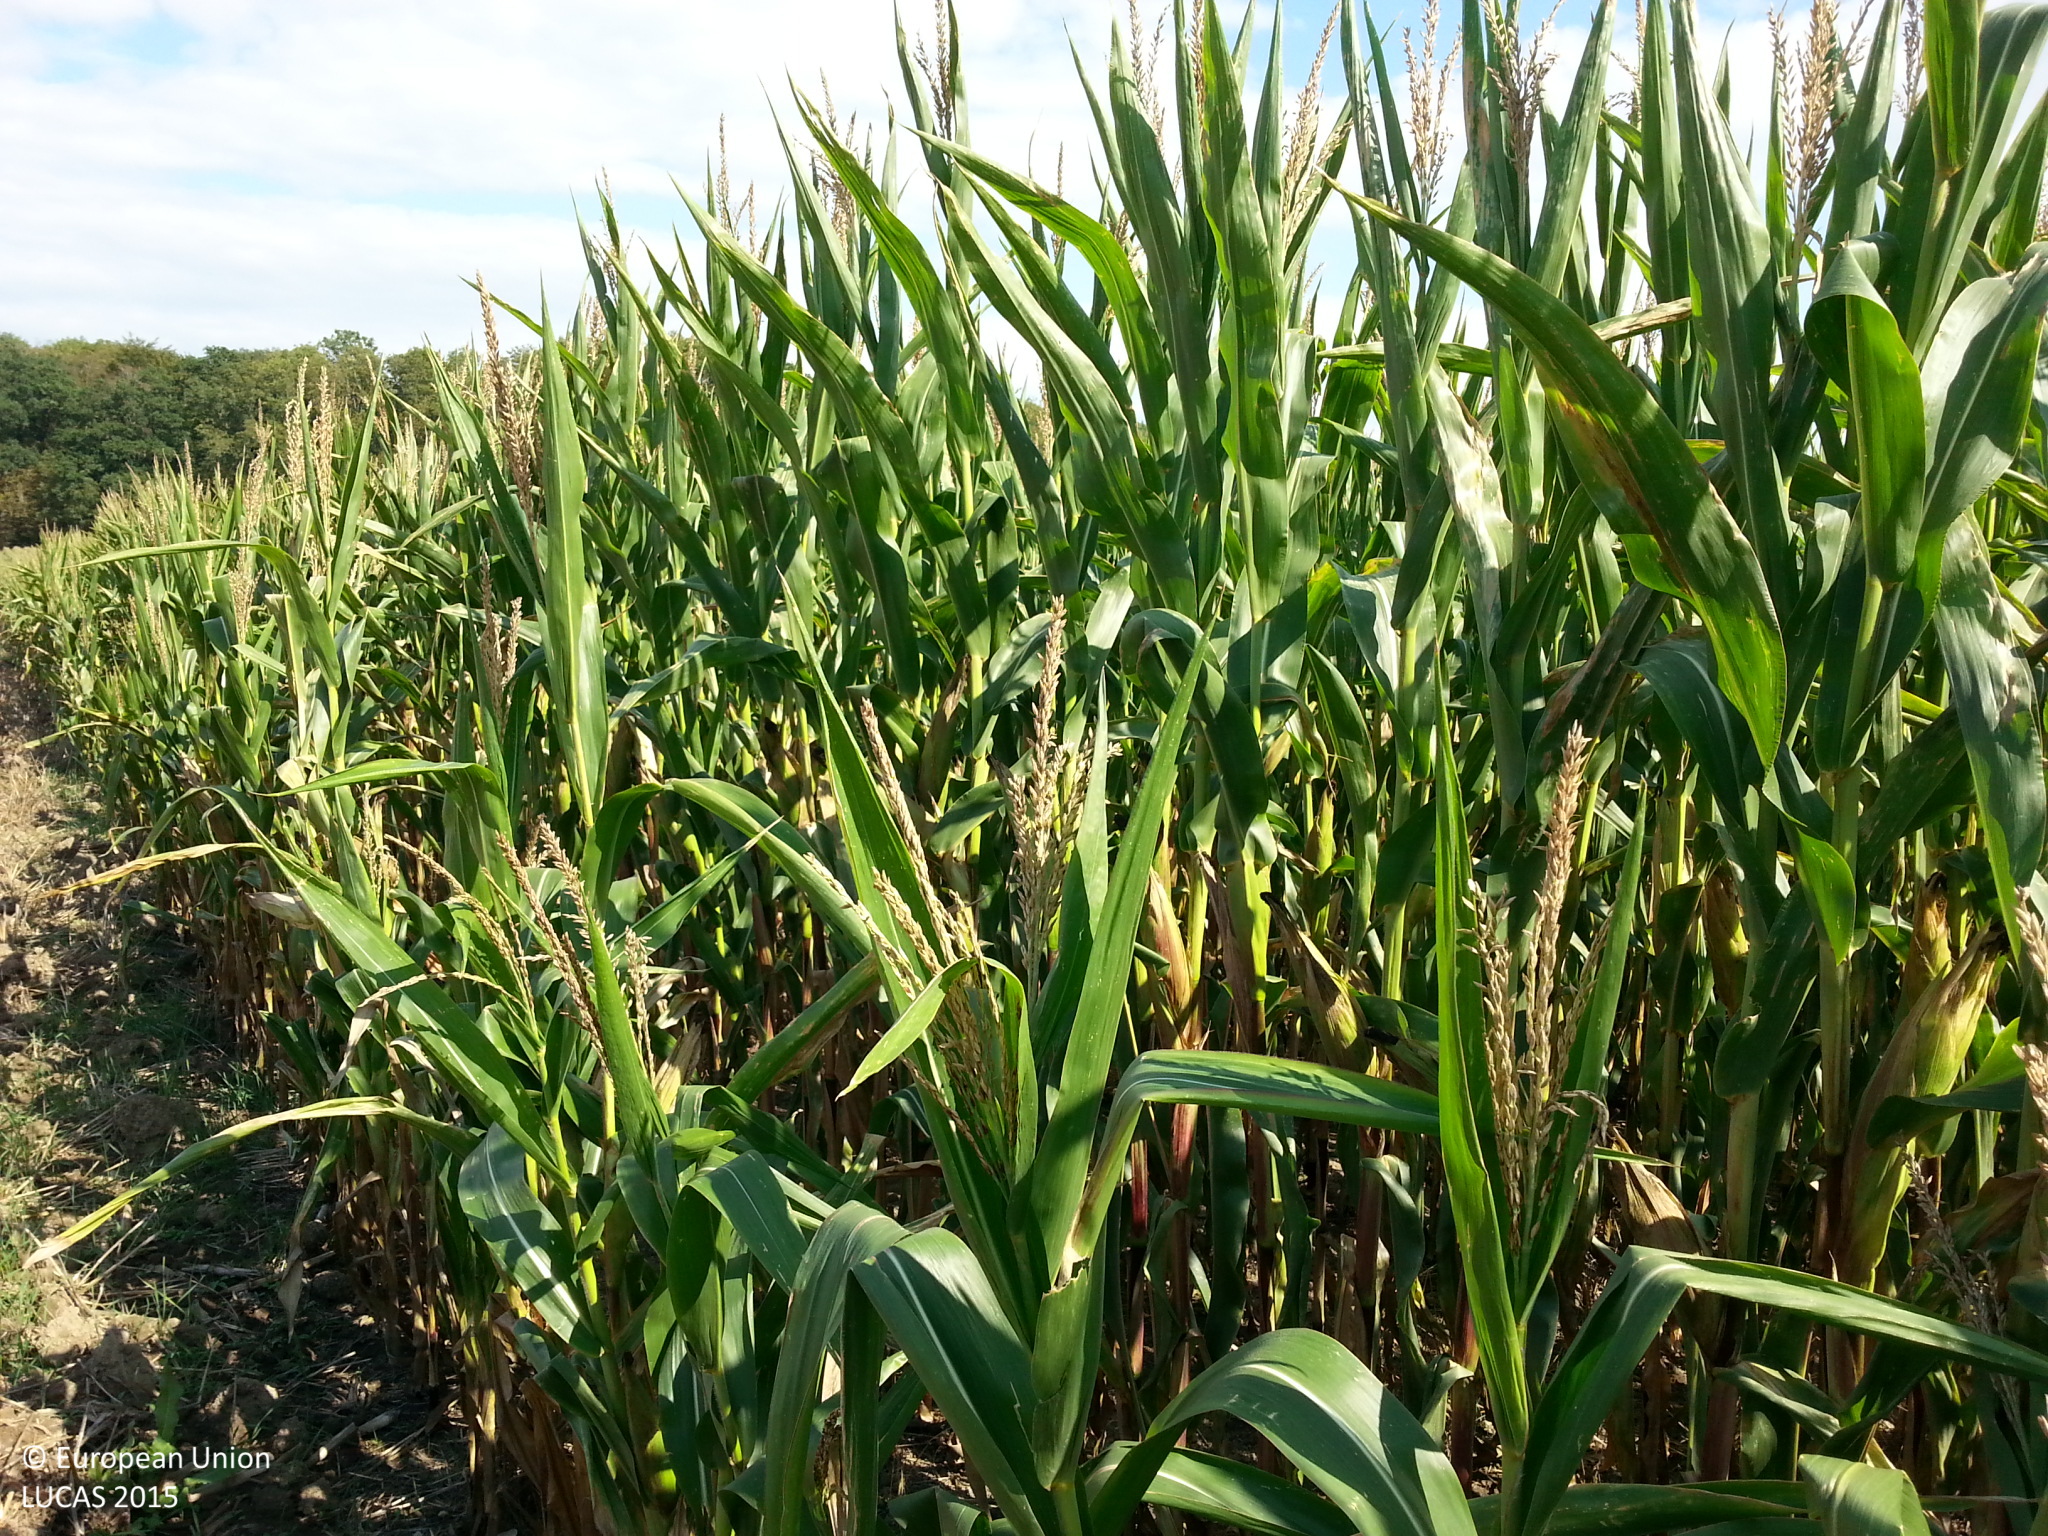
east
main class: Cropland
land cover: Maize
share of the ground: > 75 %
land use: Agriculture (excluding fallow land and kitchen gardens)
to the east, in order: Maize; Grass margins; Tracks; Ditches and canals; Broadleaved woodland
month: September
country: DE
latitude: 49.3569
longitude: 9.9037
